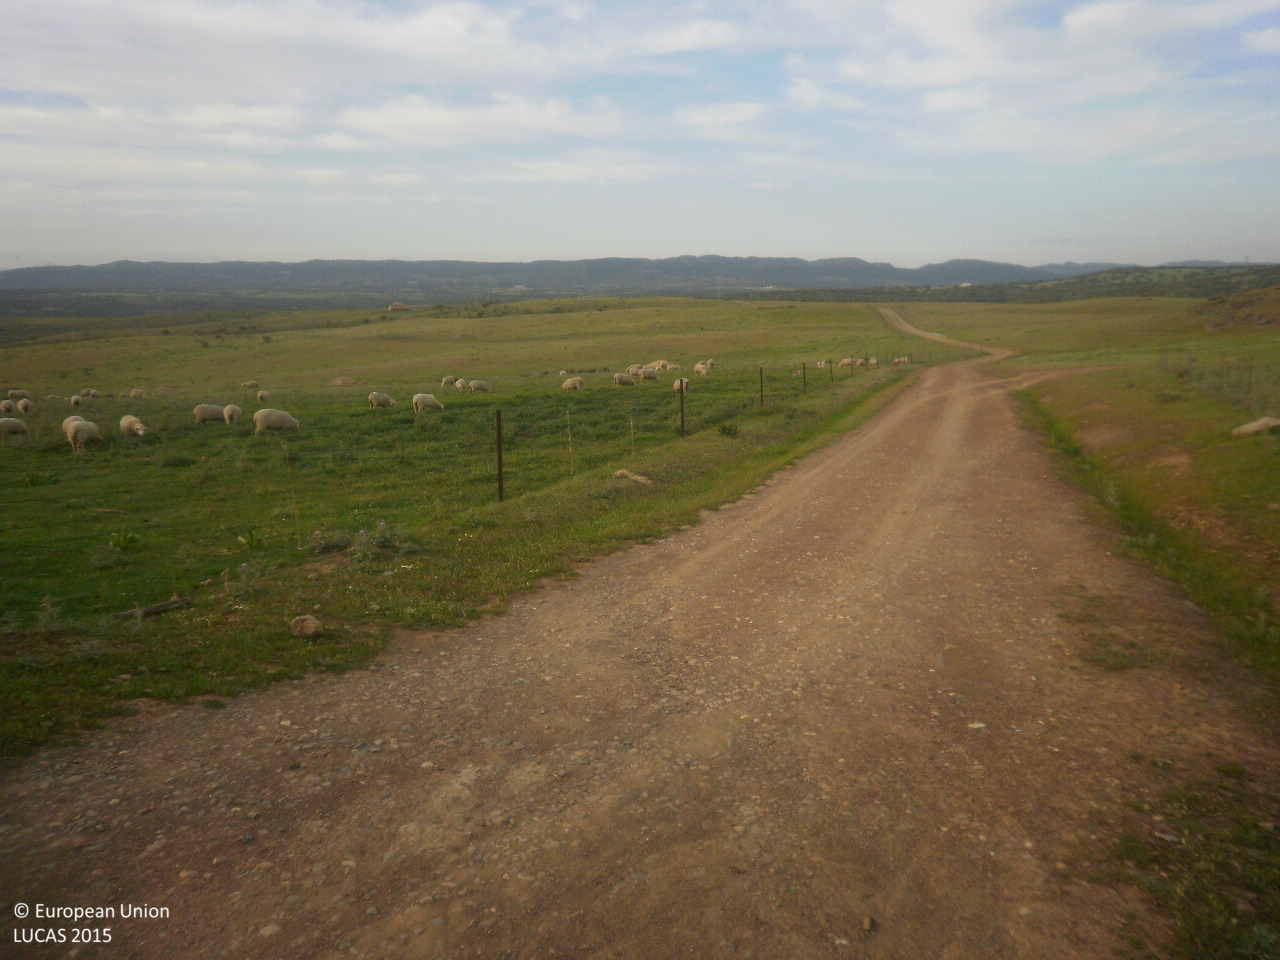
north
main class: Grassland
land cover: Grassland without tree/shrub cover
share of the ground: > 75 %
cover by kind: herbaceous plants 100 %
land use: Agriculture (excluding fallow land and kitchen gardens)
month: April
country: ES
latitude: 39.0831
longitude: -5.2660
